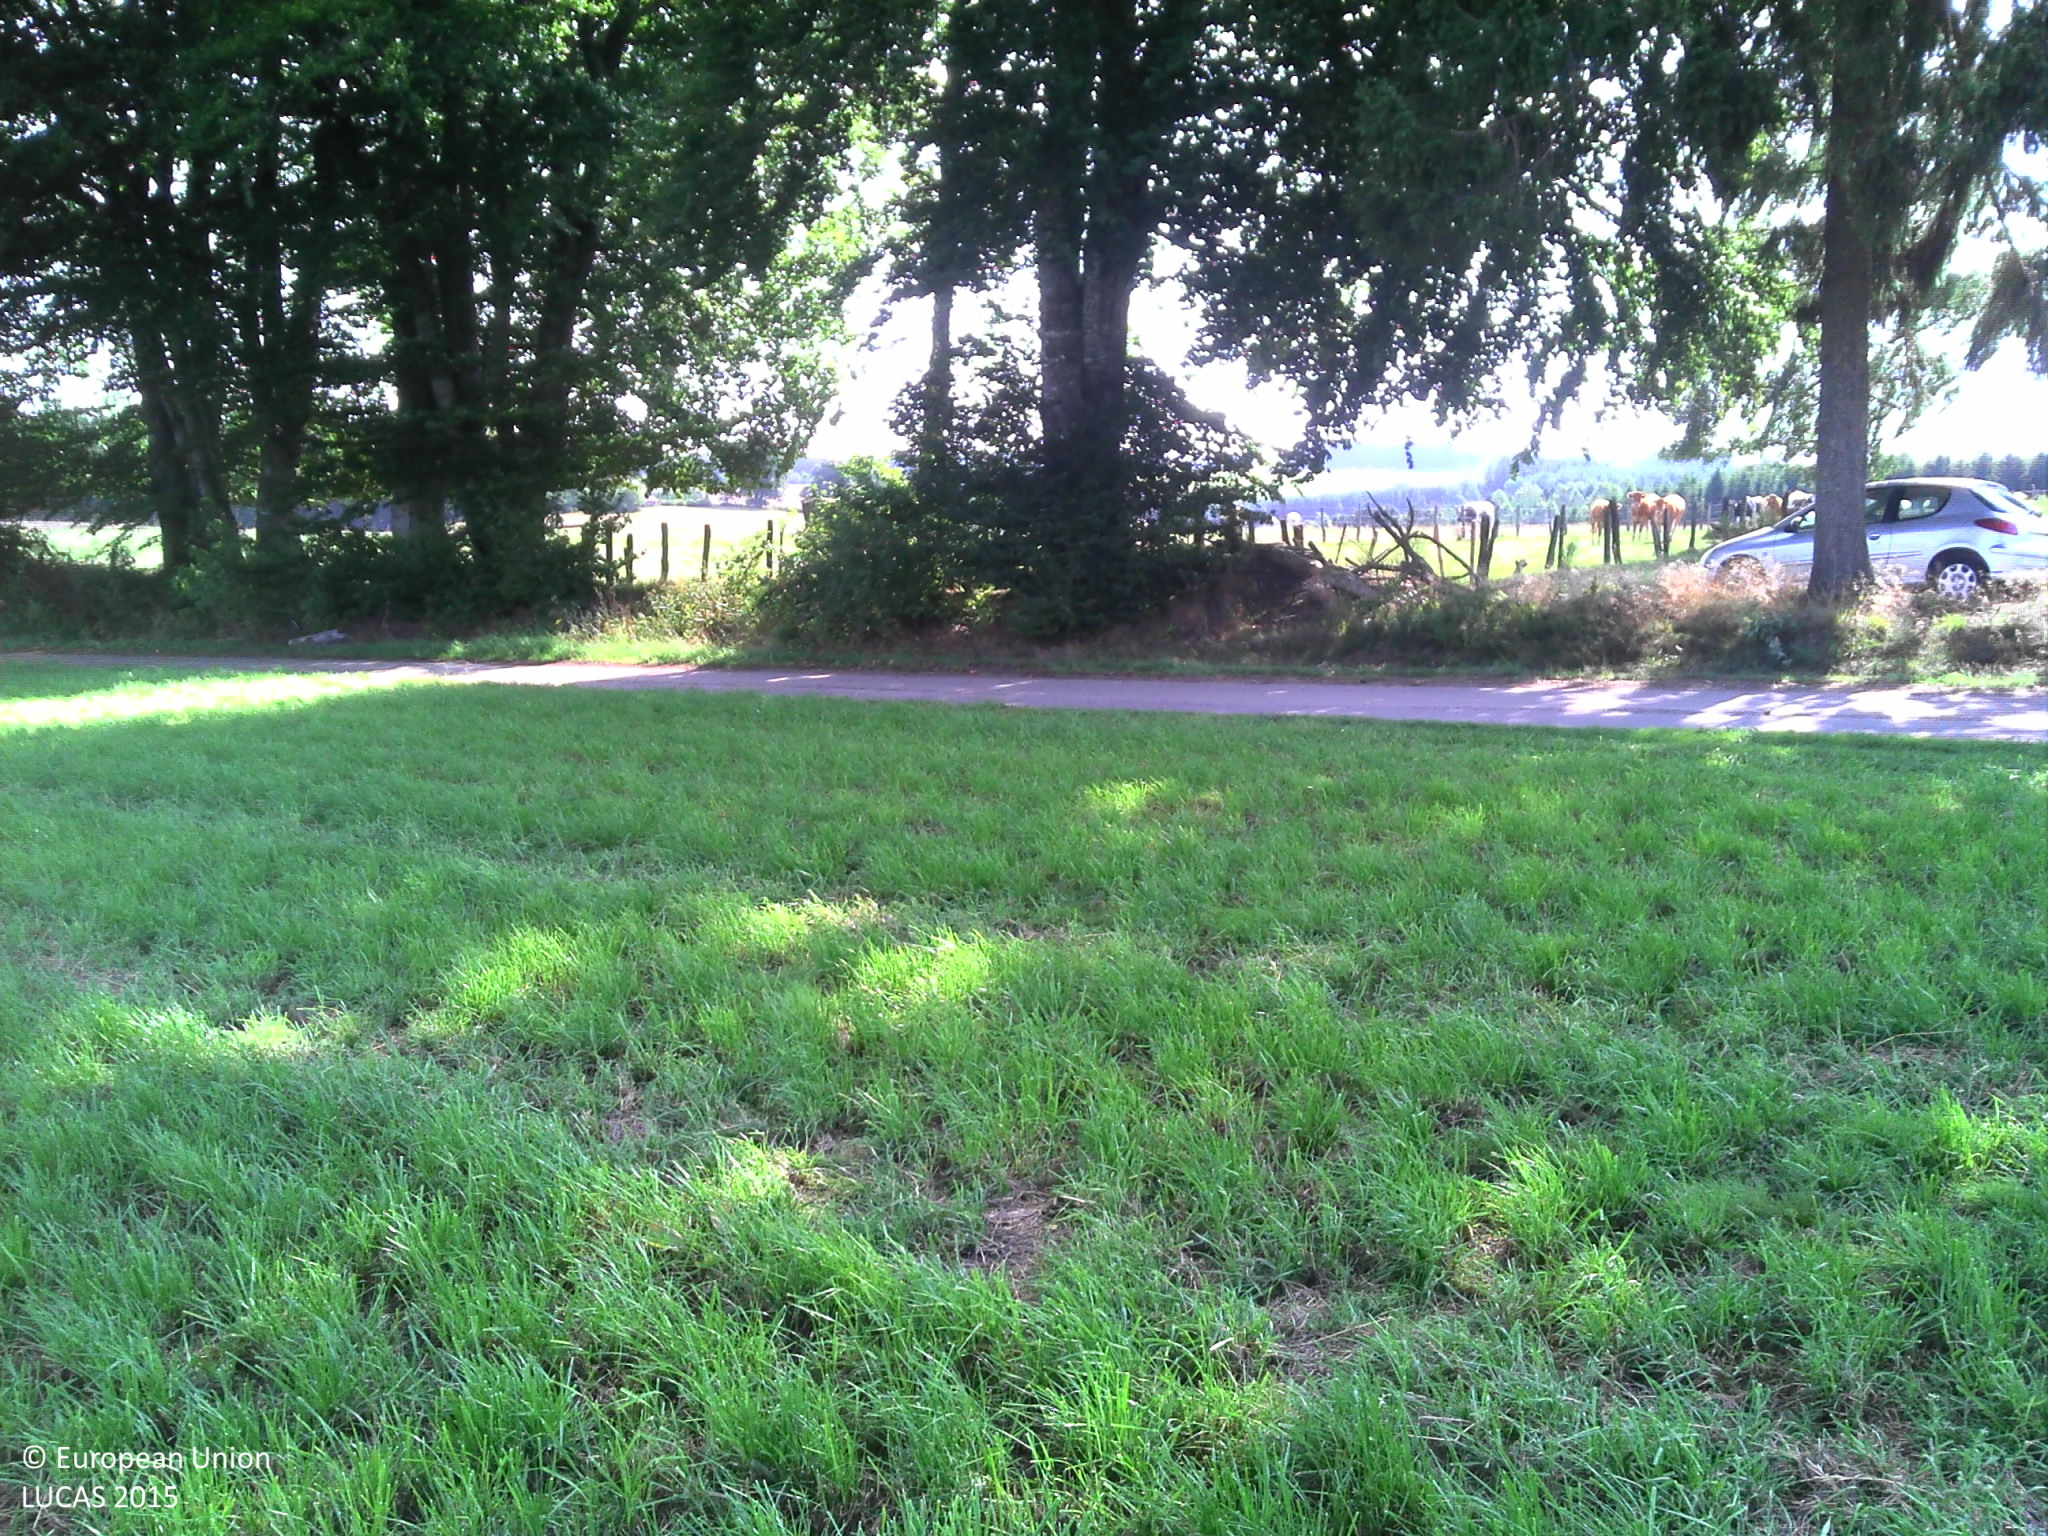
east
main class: Cropland
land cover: Temporary grasslands
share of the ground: > 75 %
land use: Agriculture (excluding fallow land and kitchen gardens)
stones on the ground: < 10 %
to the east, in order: Temporary grasslands; Paved roads, cycling and walking lanes; Grass margins; Broadleaved woodland; Fences; Grassland without tree/shrub cover; Fences; Grassland without tree/shrub cover
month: August
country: LU
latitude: 50.0747
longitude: 5.9049
